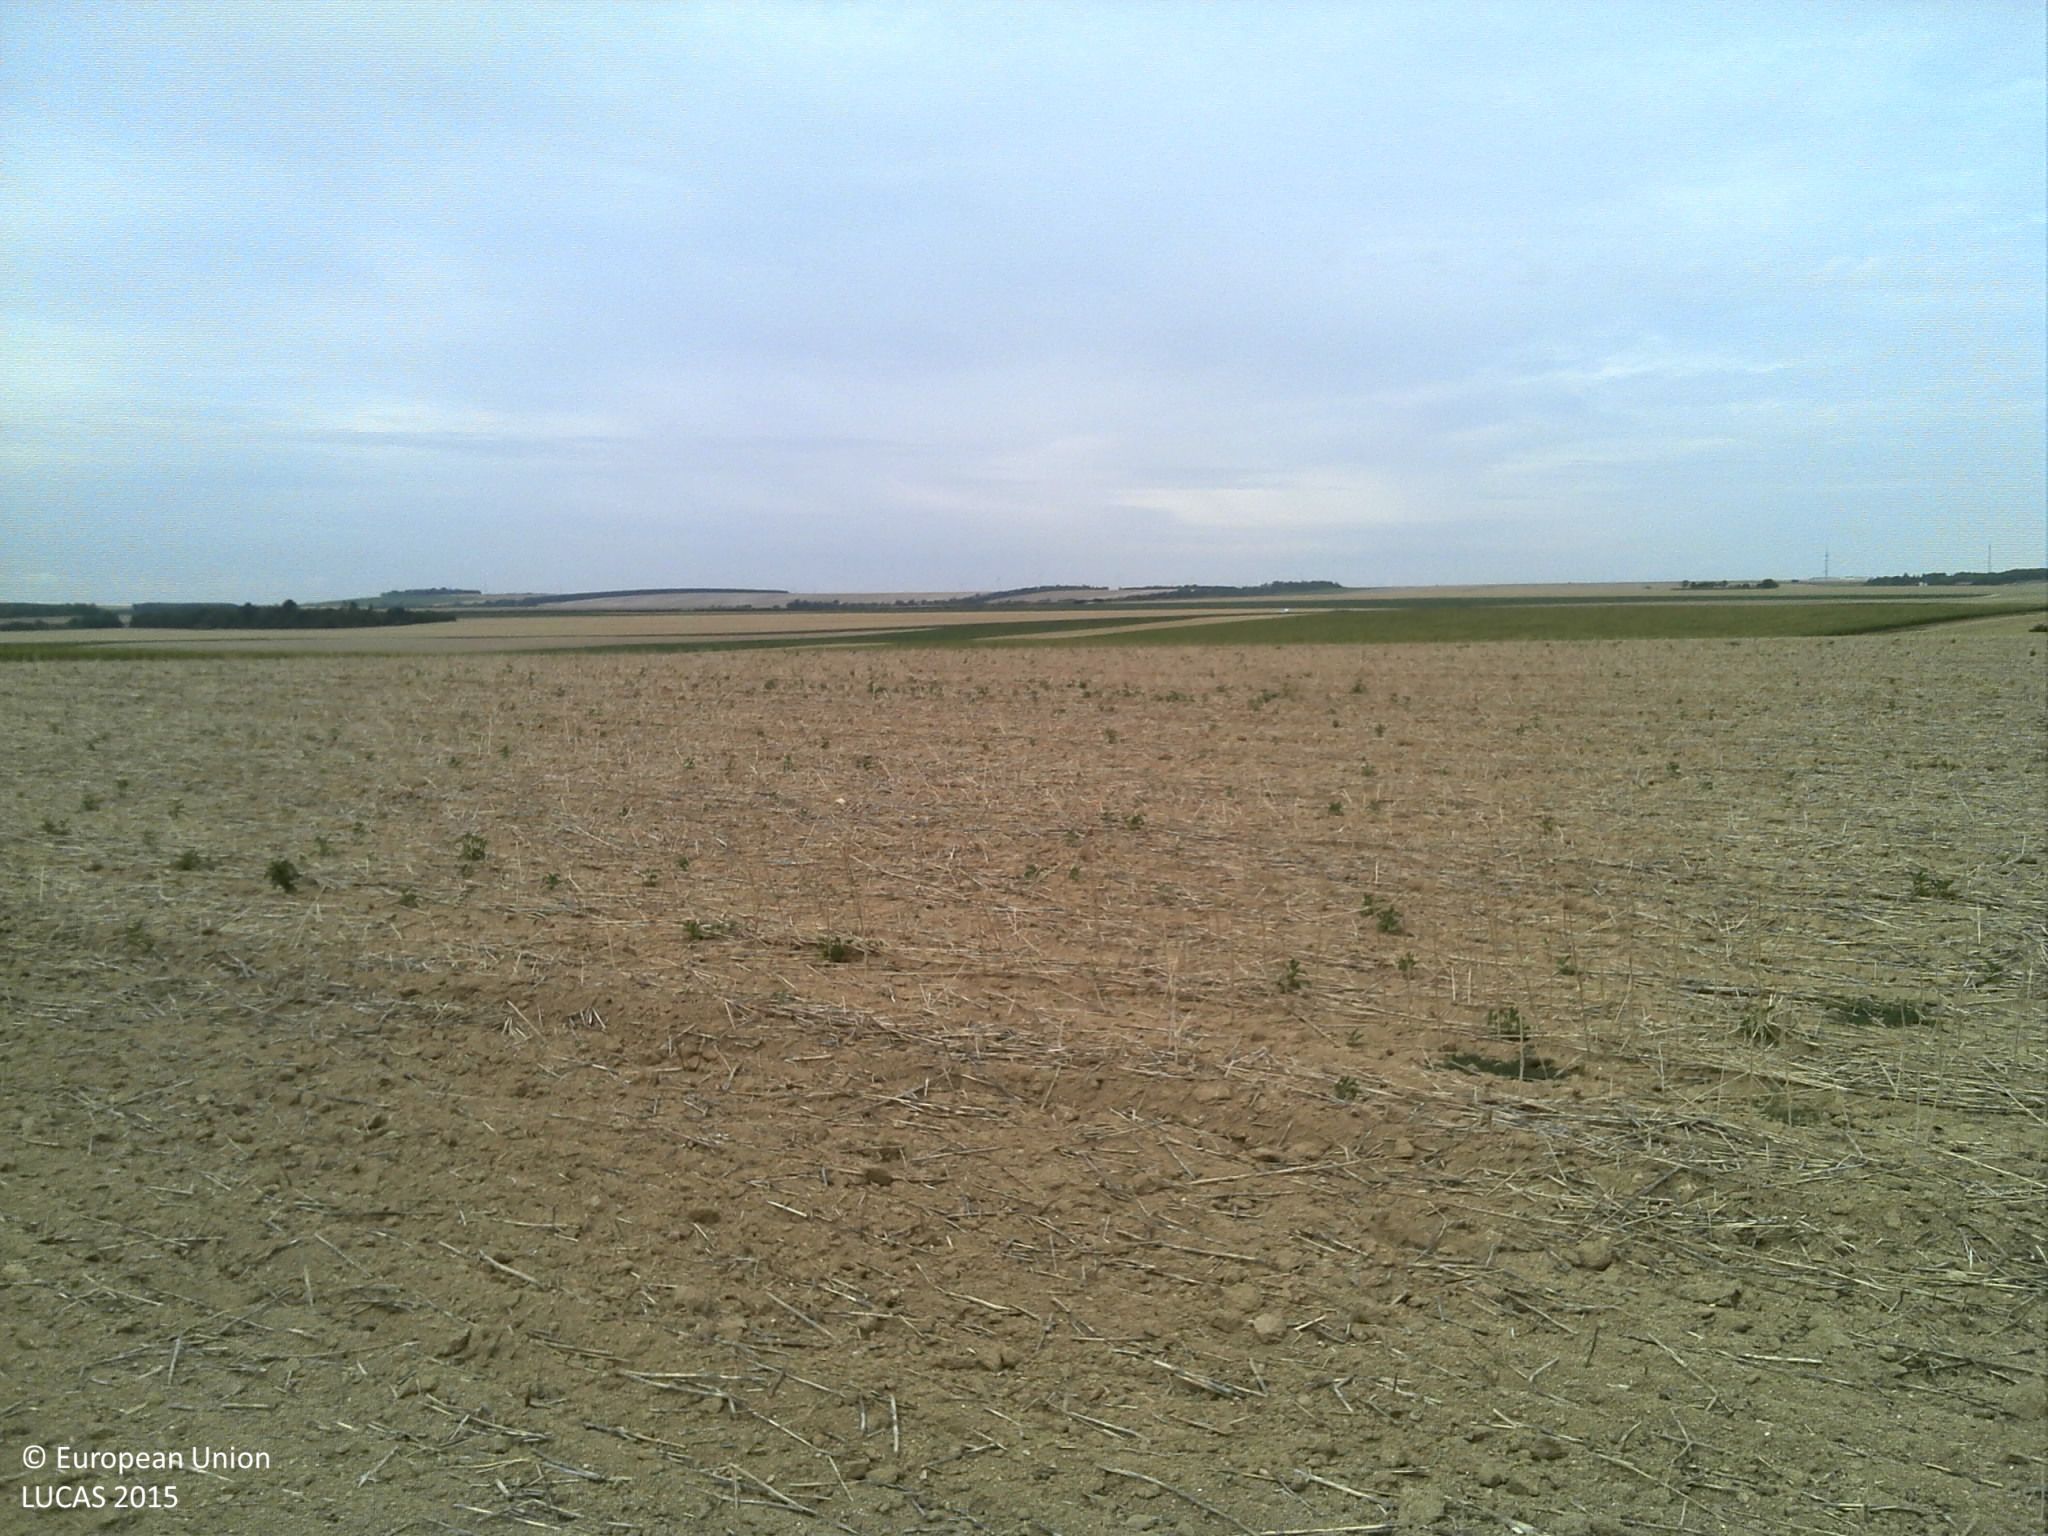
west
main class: Cropland
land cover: Other fibre and oleaginous crops
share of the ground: 10 - 25 %
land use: Agriculture (excluding fallow land and kitchen gardens)
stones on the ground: < 10 %
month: August
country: FR
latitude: 48.3943
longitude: 4.1755
